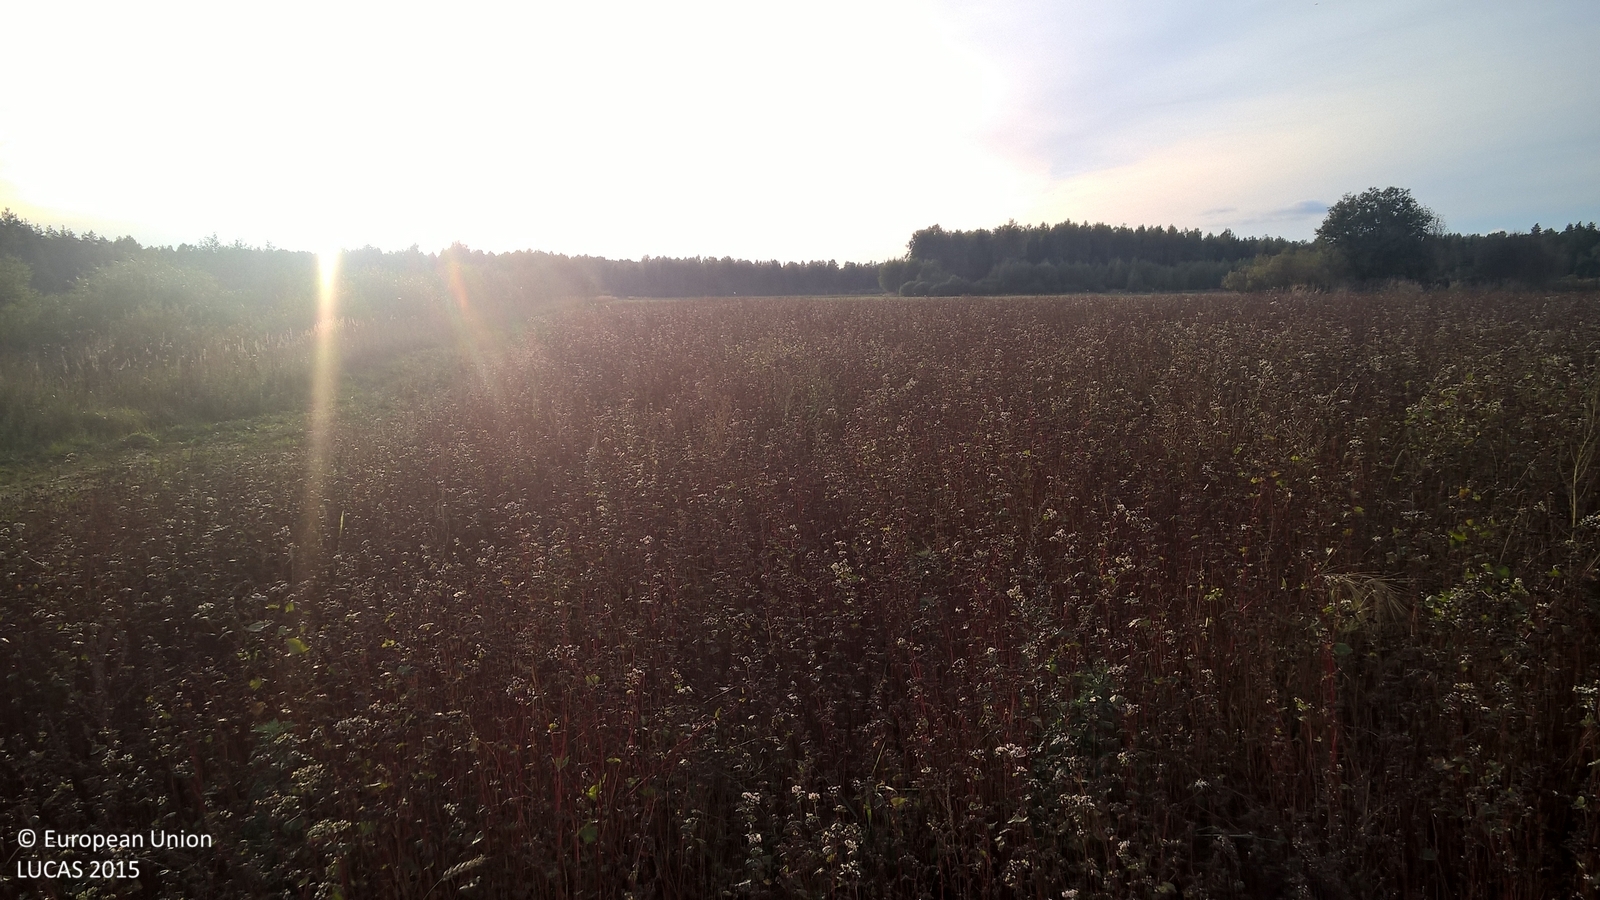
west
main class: Cropland
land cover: Other cereals
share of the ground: > 75 %
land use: Agriculture (excluding fallow land and kitchen gardens)
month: September
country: LV
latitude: 57.8046
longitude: 25.6836
